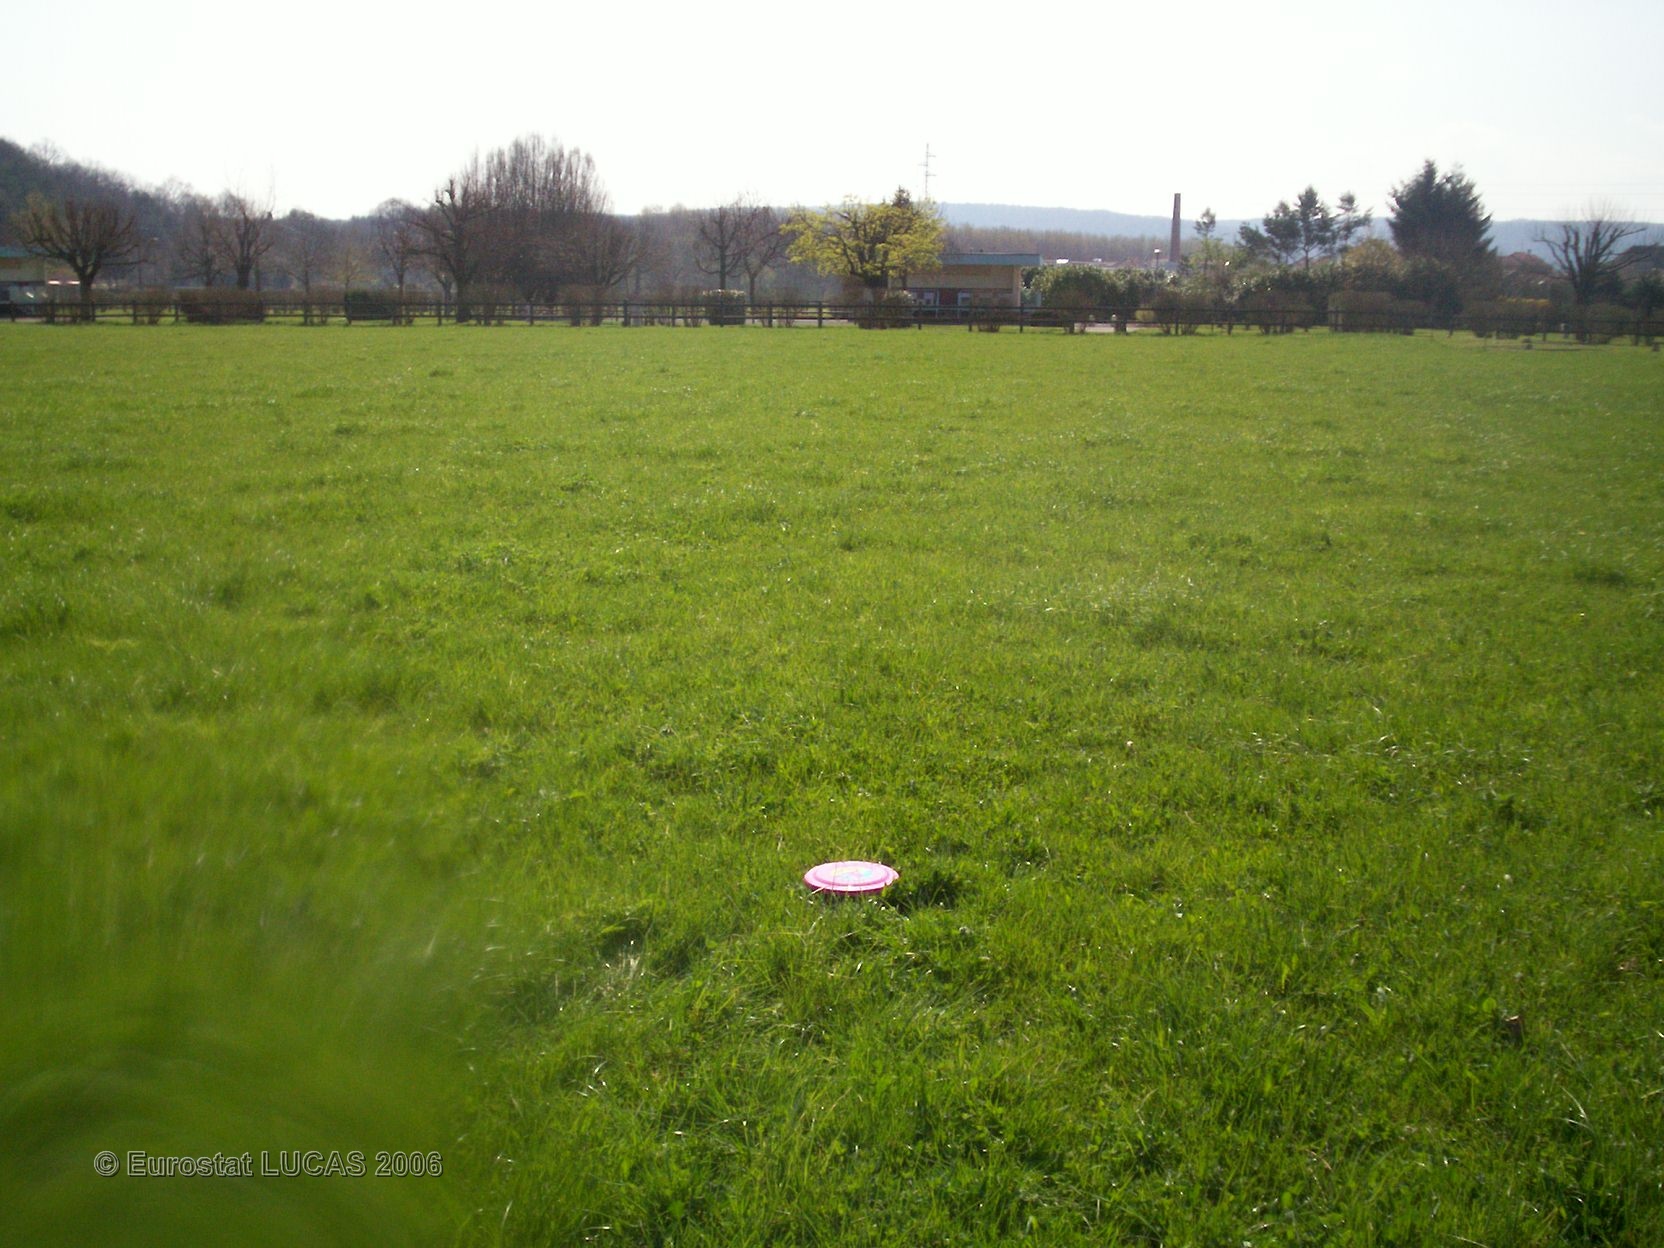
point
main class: Grassland
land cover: Grassland without tree/shrub cover
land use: Agriculture (excluding fallow land and kitchen gardens)
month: April
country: FR
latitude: 47.4568
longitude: 6.8050
